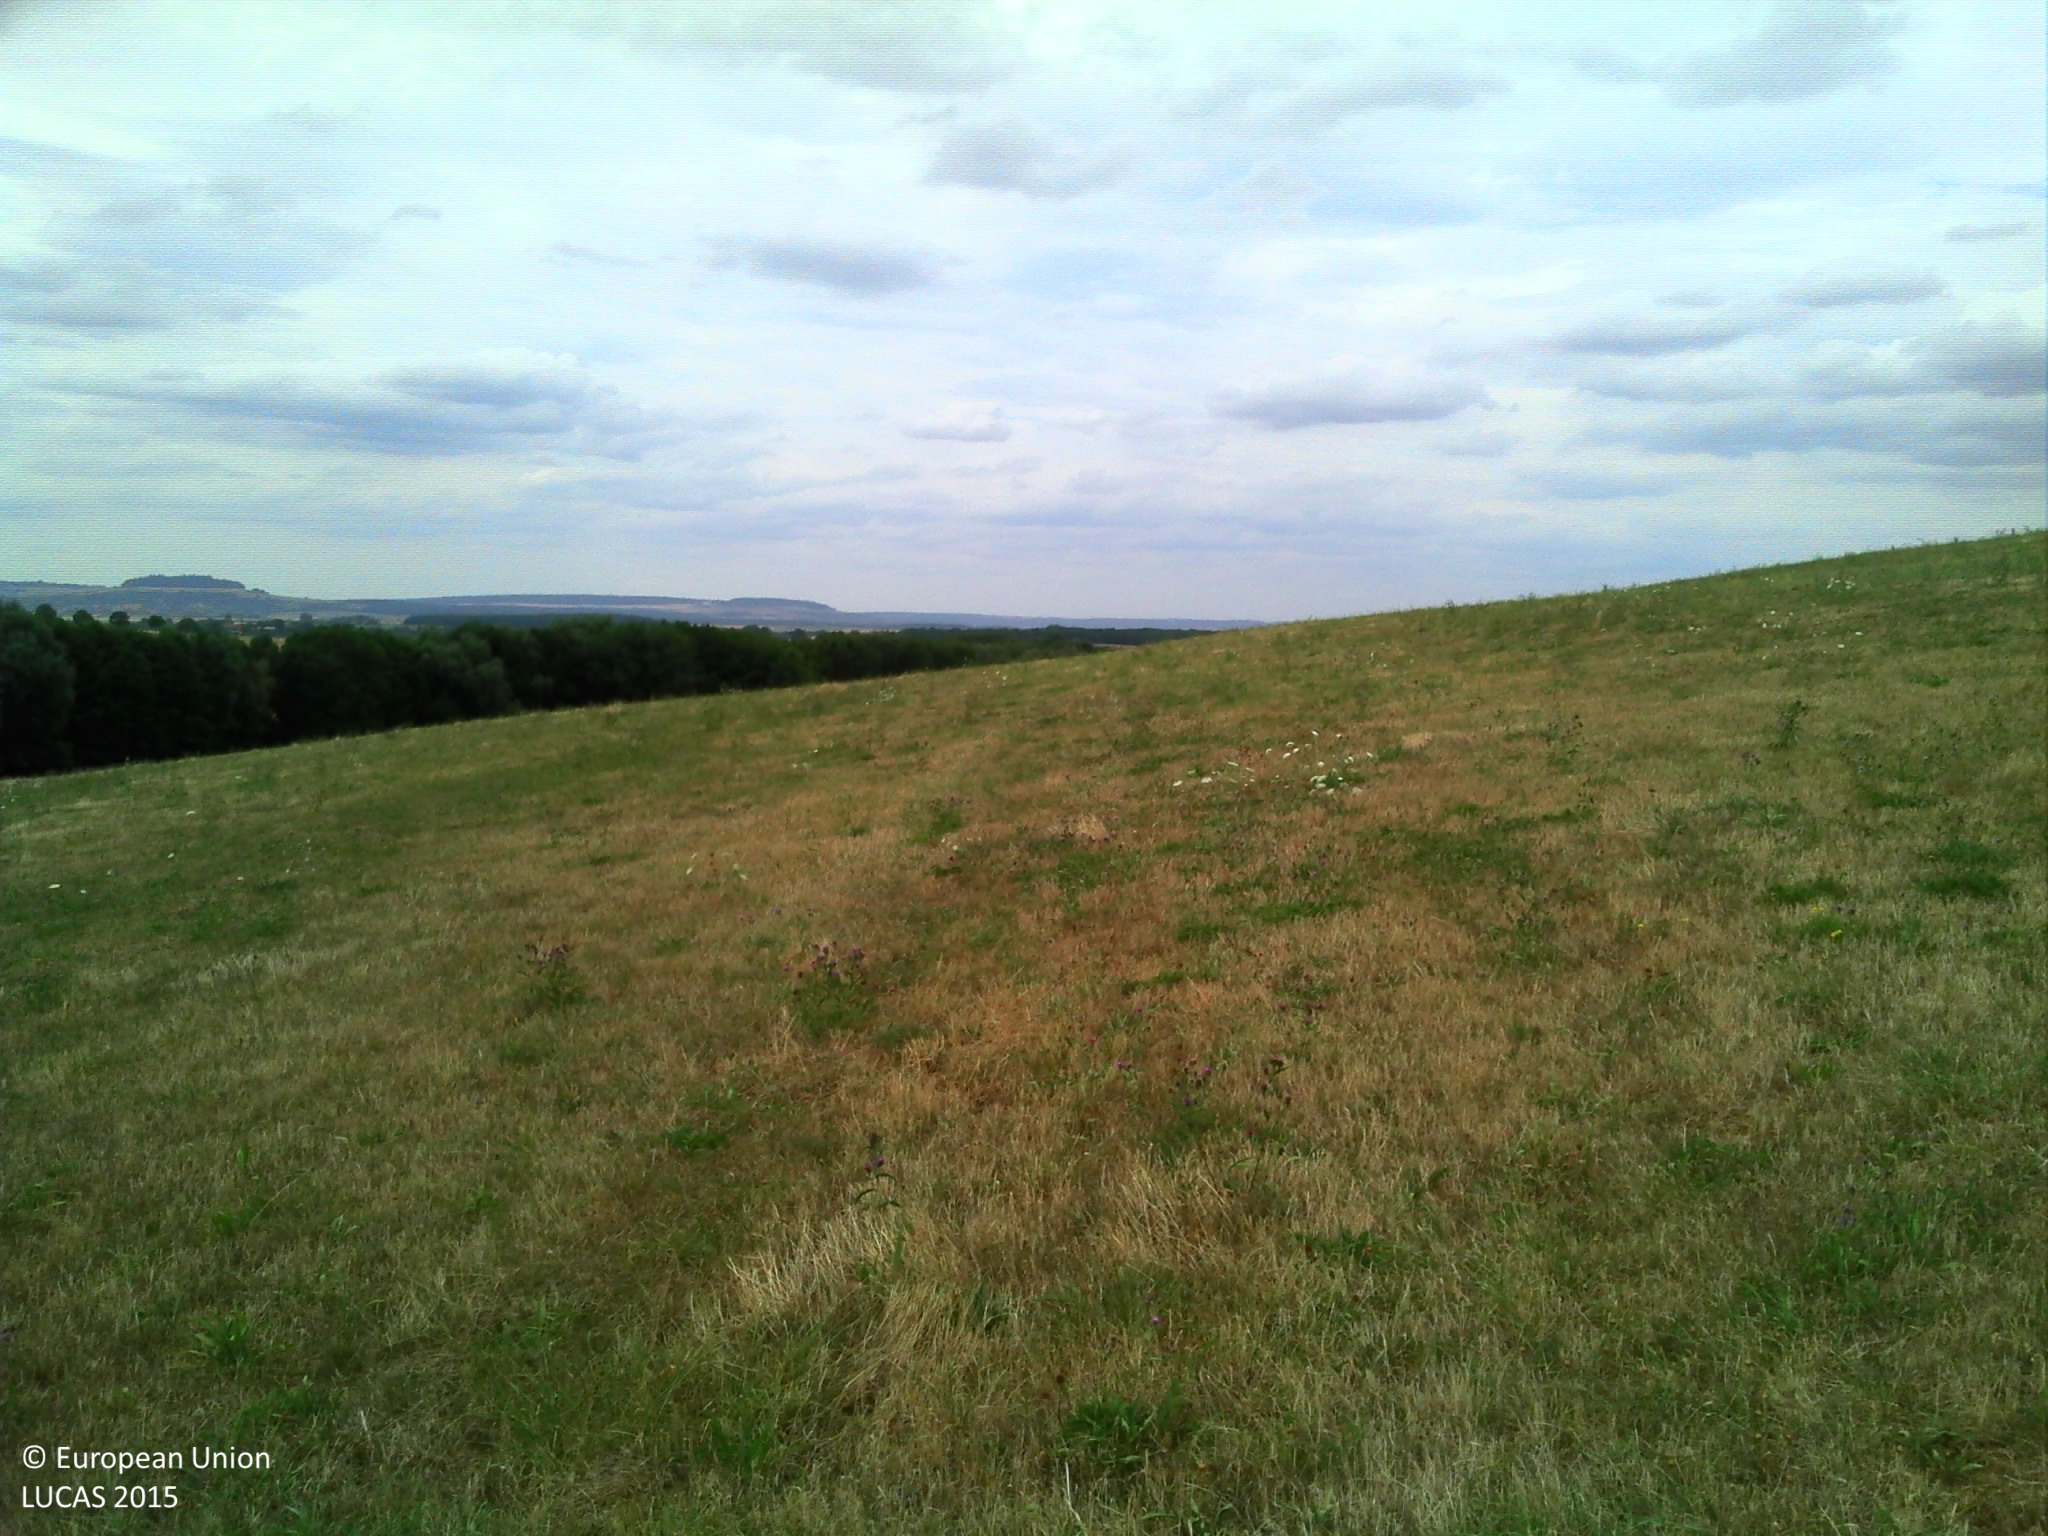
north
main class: Grassland
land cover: Grassland without tree/shrub cover
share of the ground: > 75 %
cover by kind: herbaceous plants 100 %
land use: Agriculture (excluding fallow land and kitchen gardens)
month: July
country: FR
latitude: 48.4237
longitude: 6.0677
